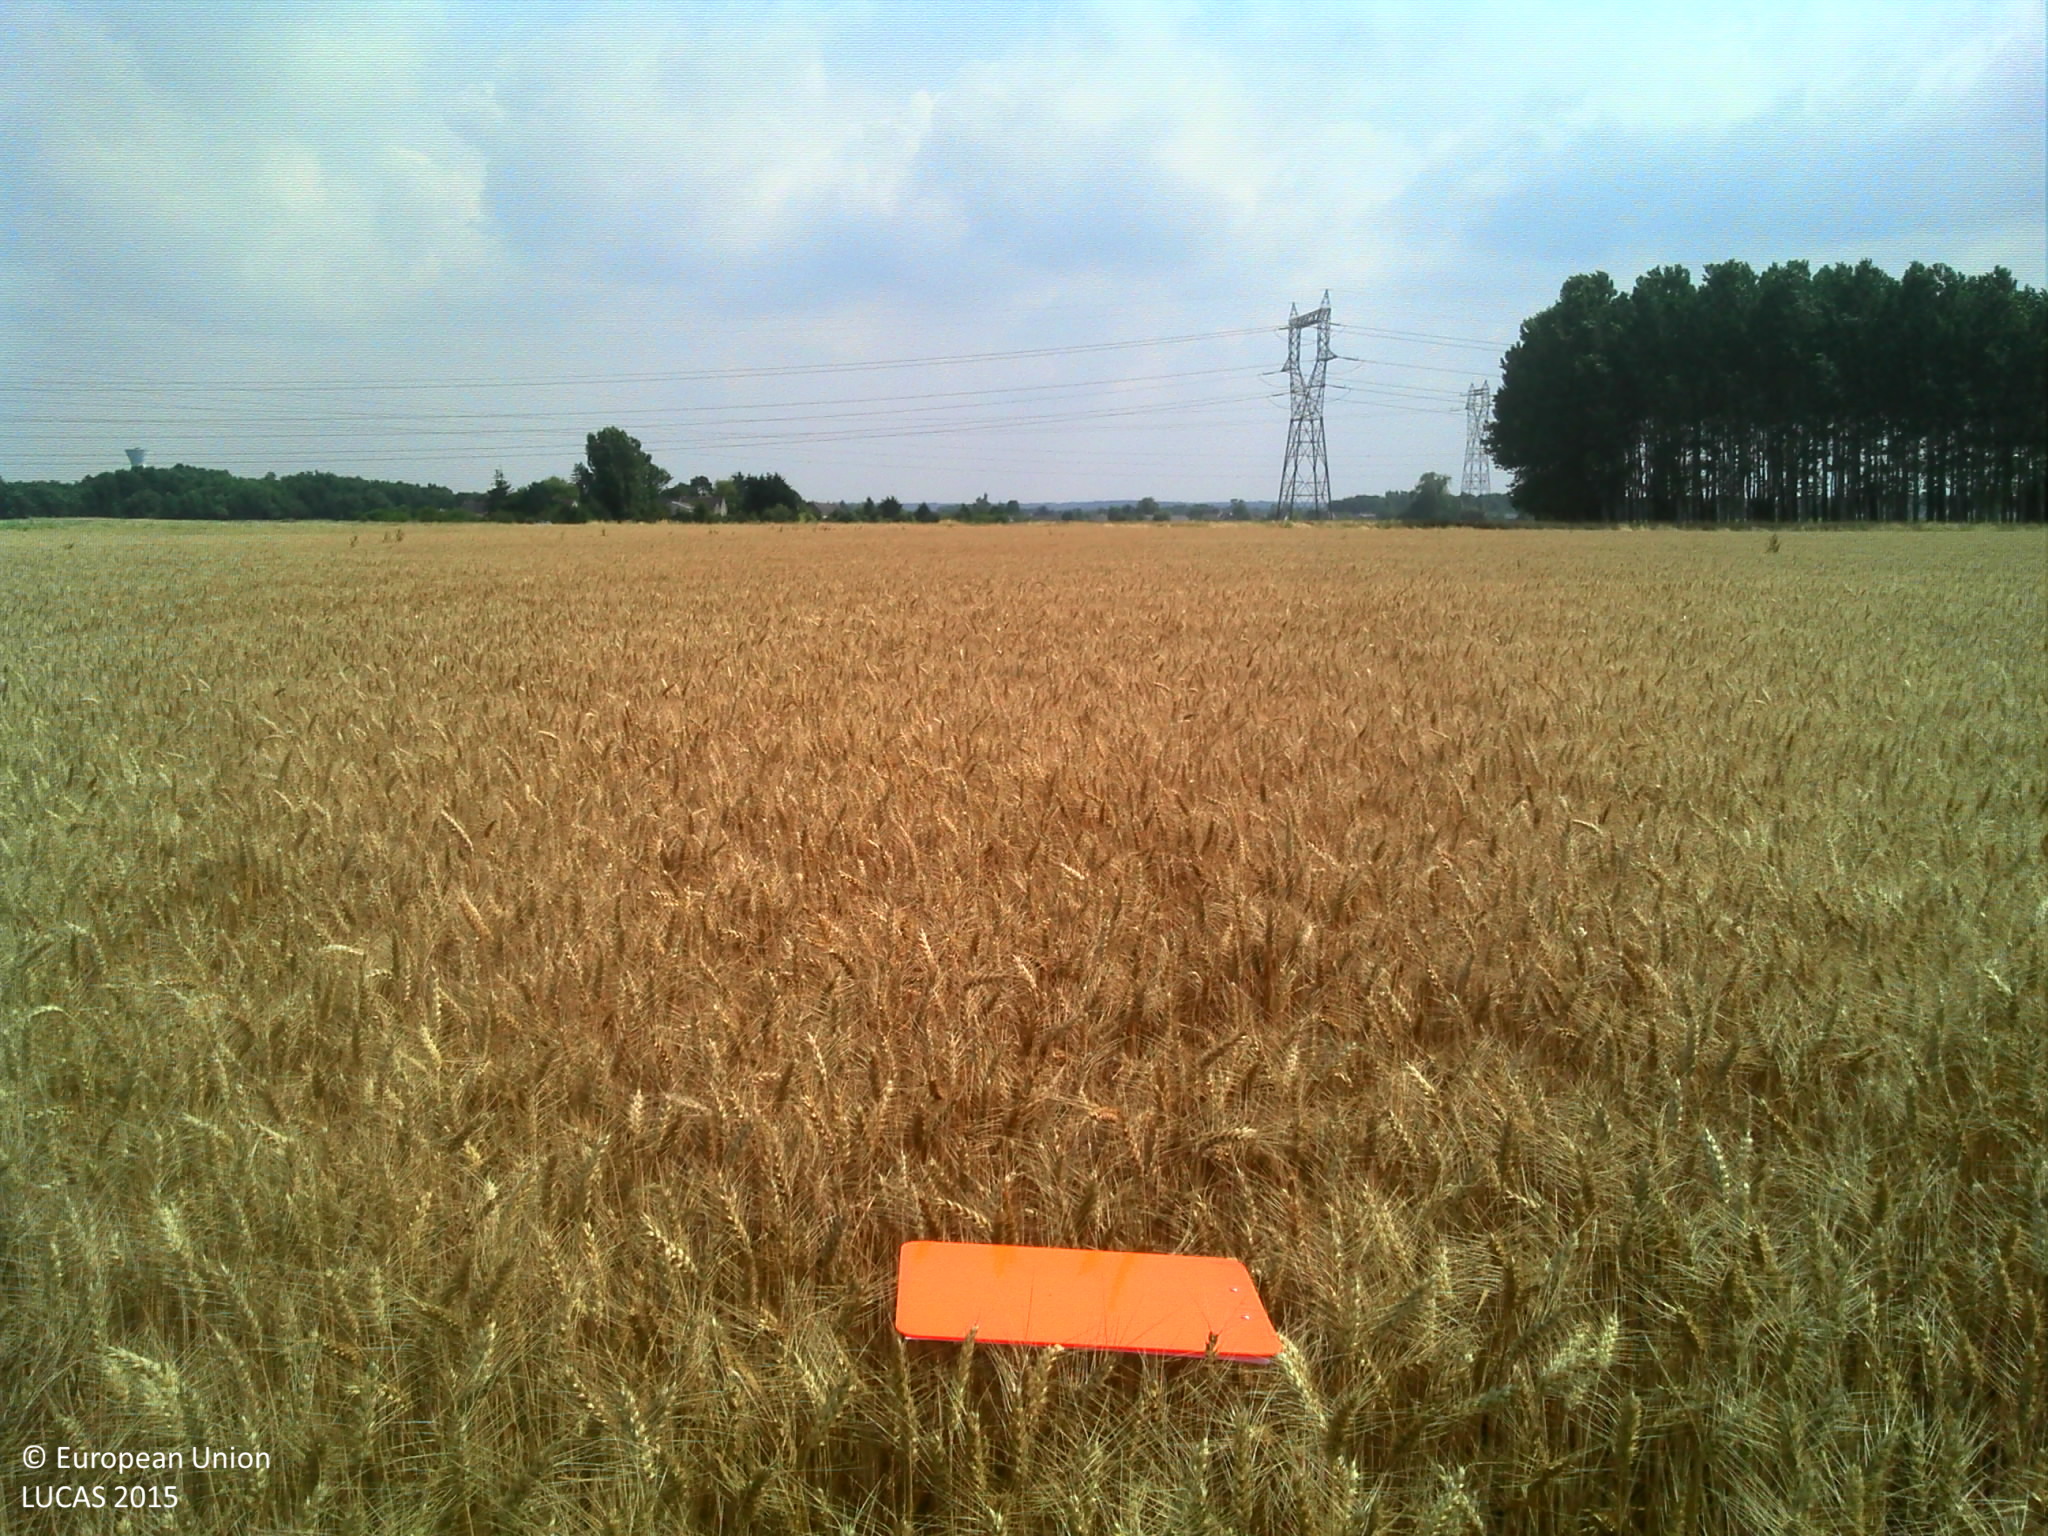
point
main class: Cropland
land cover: Durum wheat
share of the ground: > 75 %
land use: Agriculture (excluding fallow land and kitchen gardens)
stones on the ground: < 10 %
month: July
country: FR
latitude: 47.2184
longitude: 0.1388
